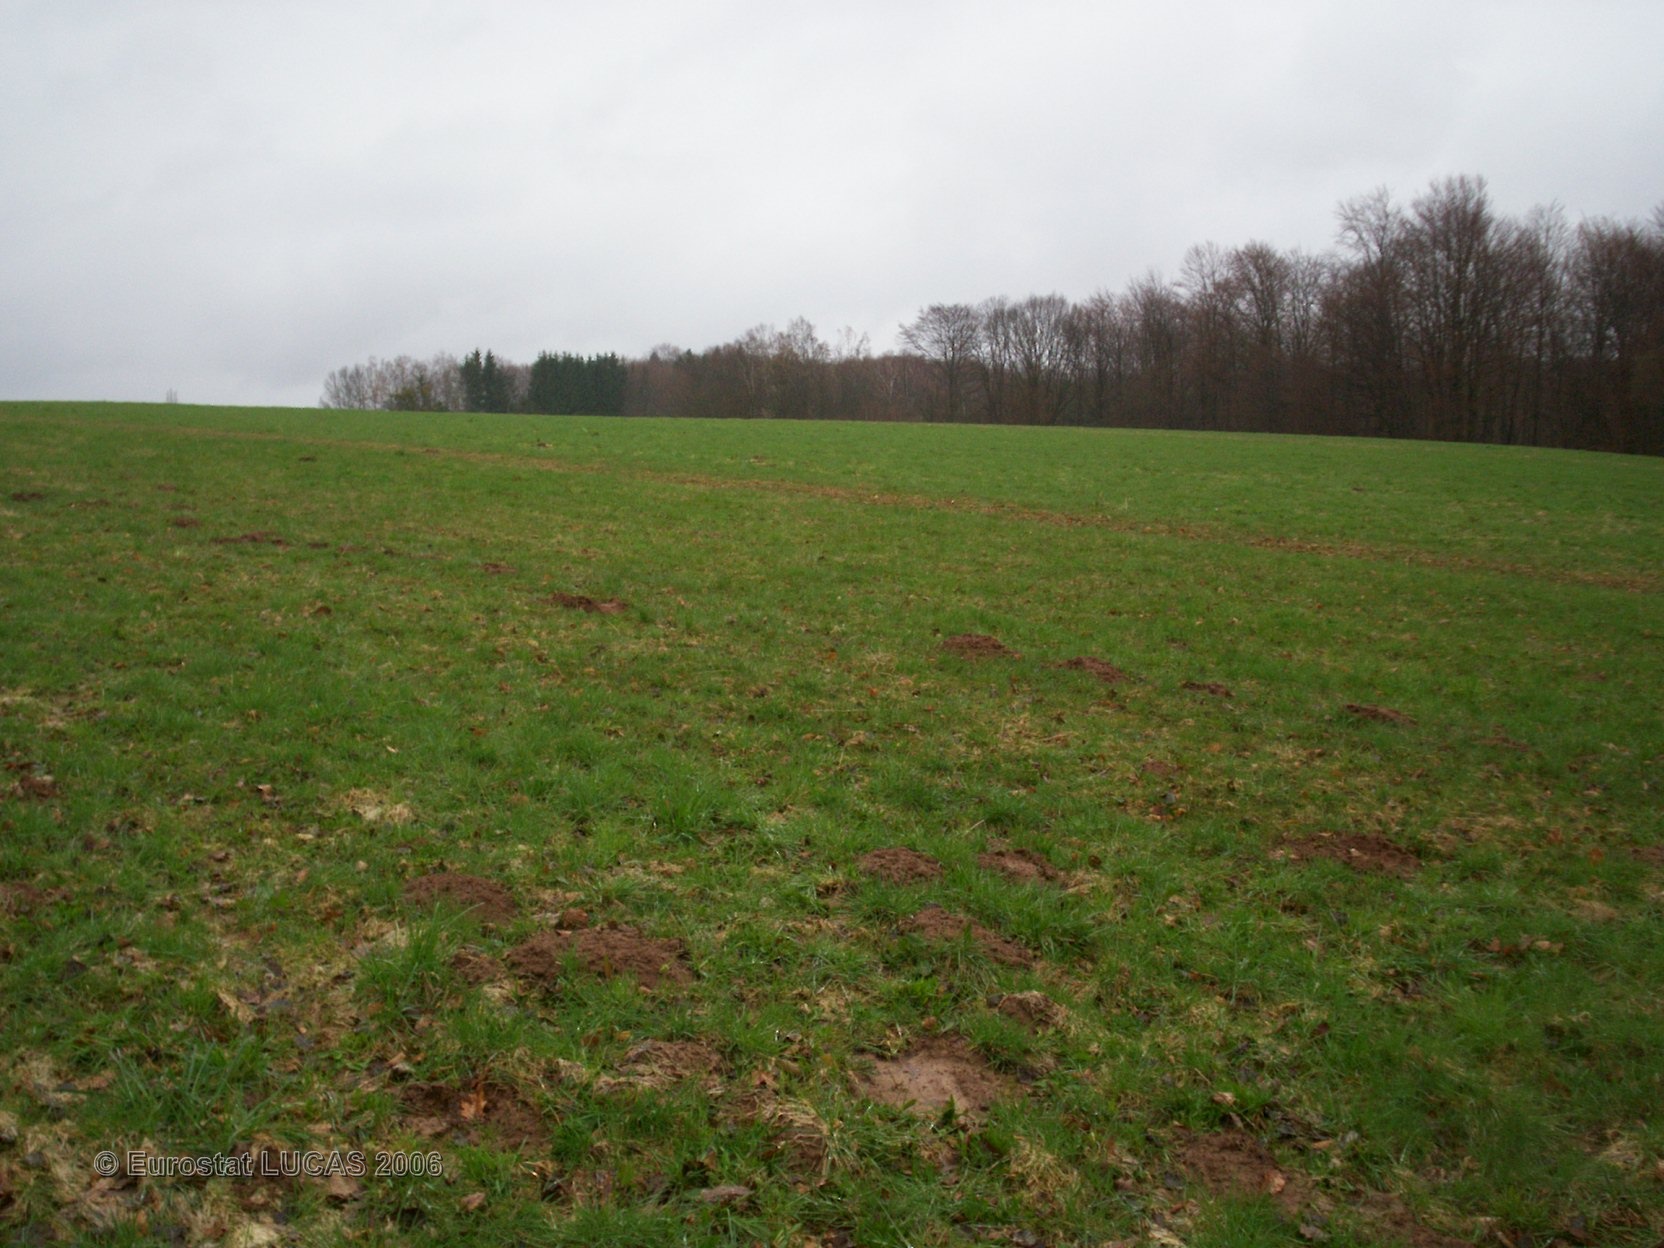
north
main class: Grassland
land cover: Grassland without tree/shrub cover
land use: Agriculture (excluding fallow land and kitchen gardens)
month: April
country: FR
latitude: 47.6498
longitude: 6.6333
